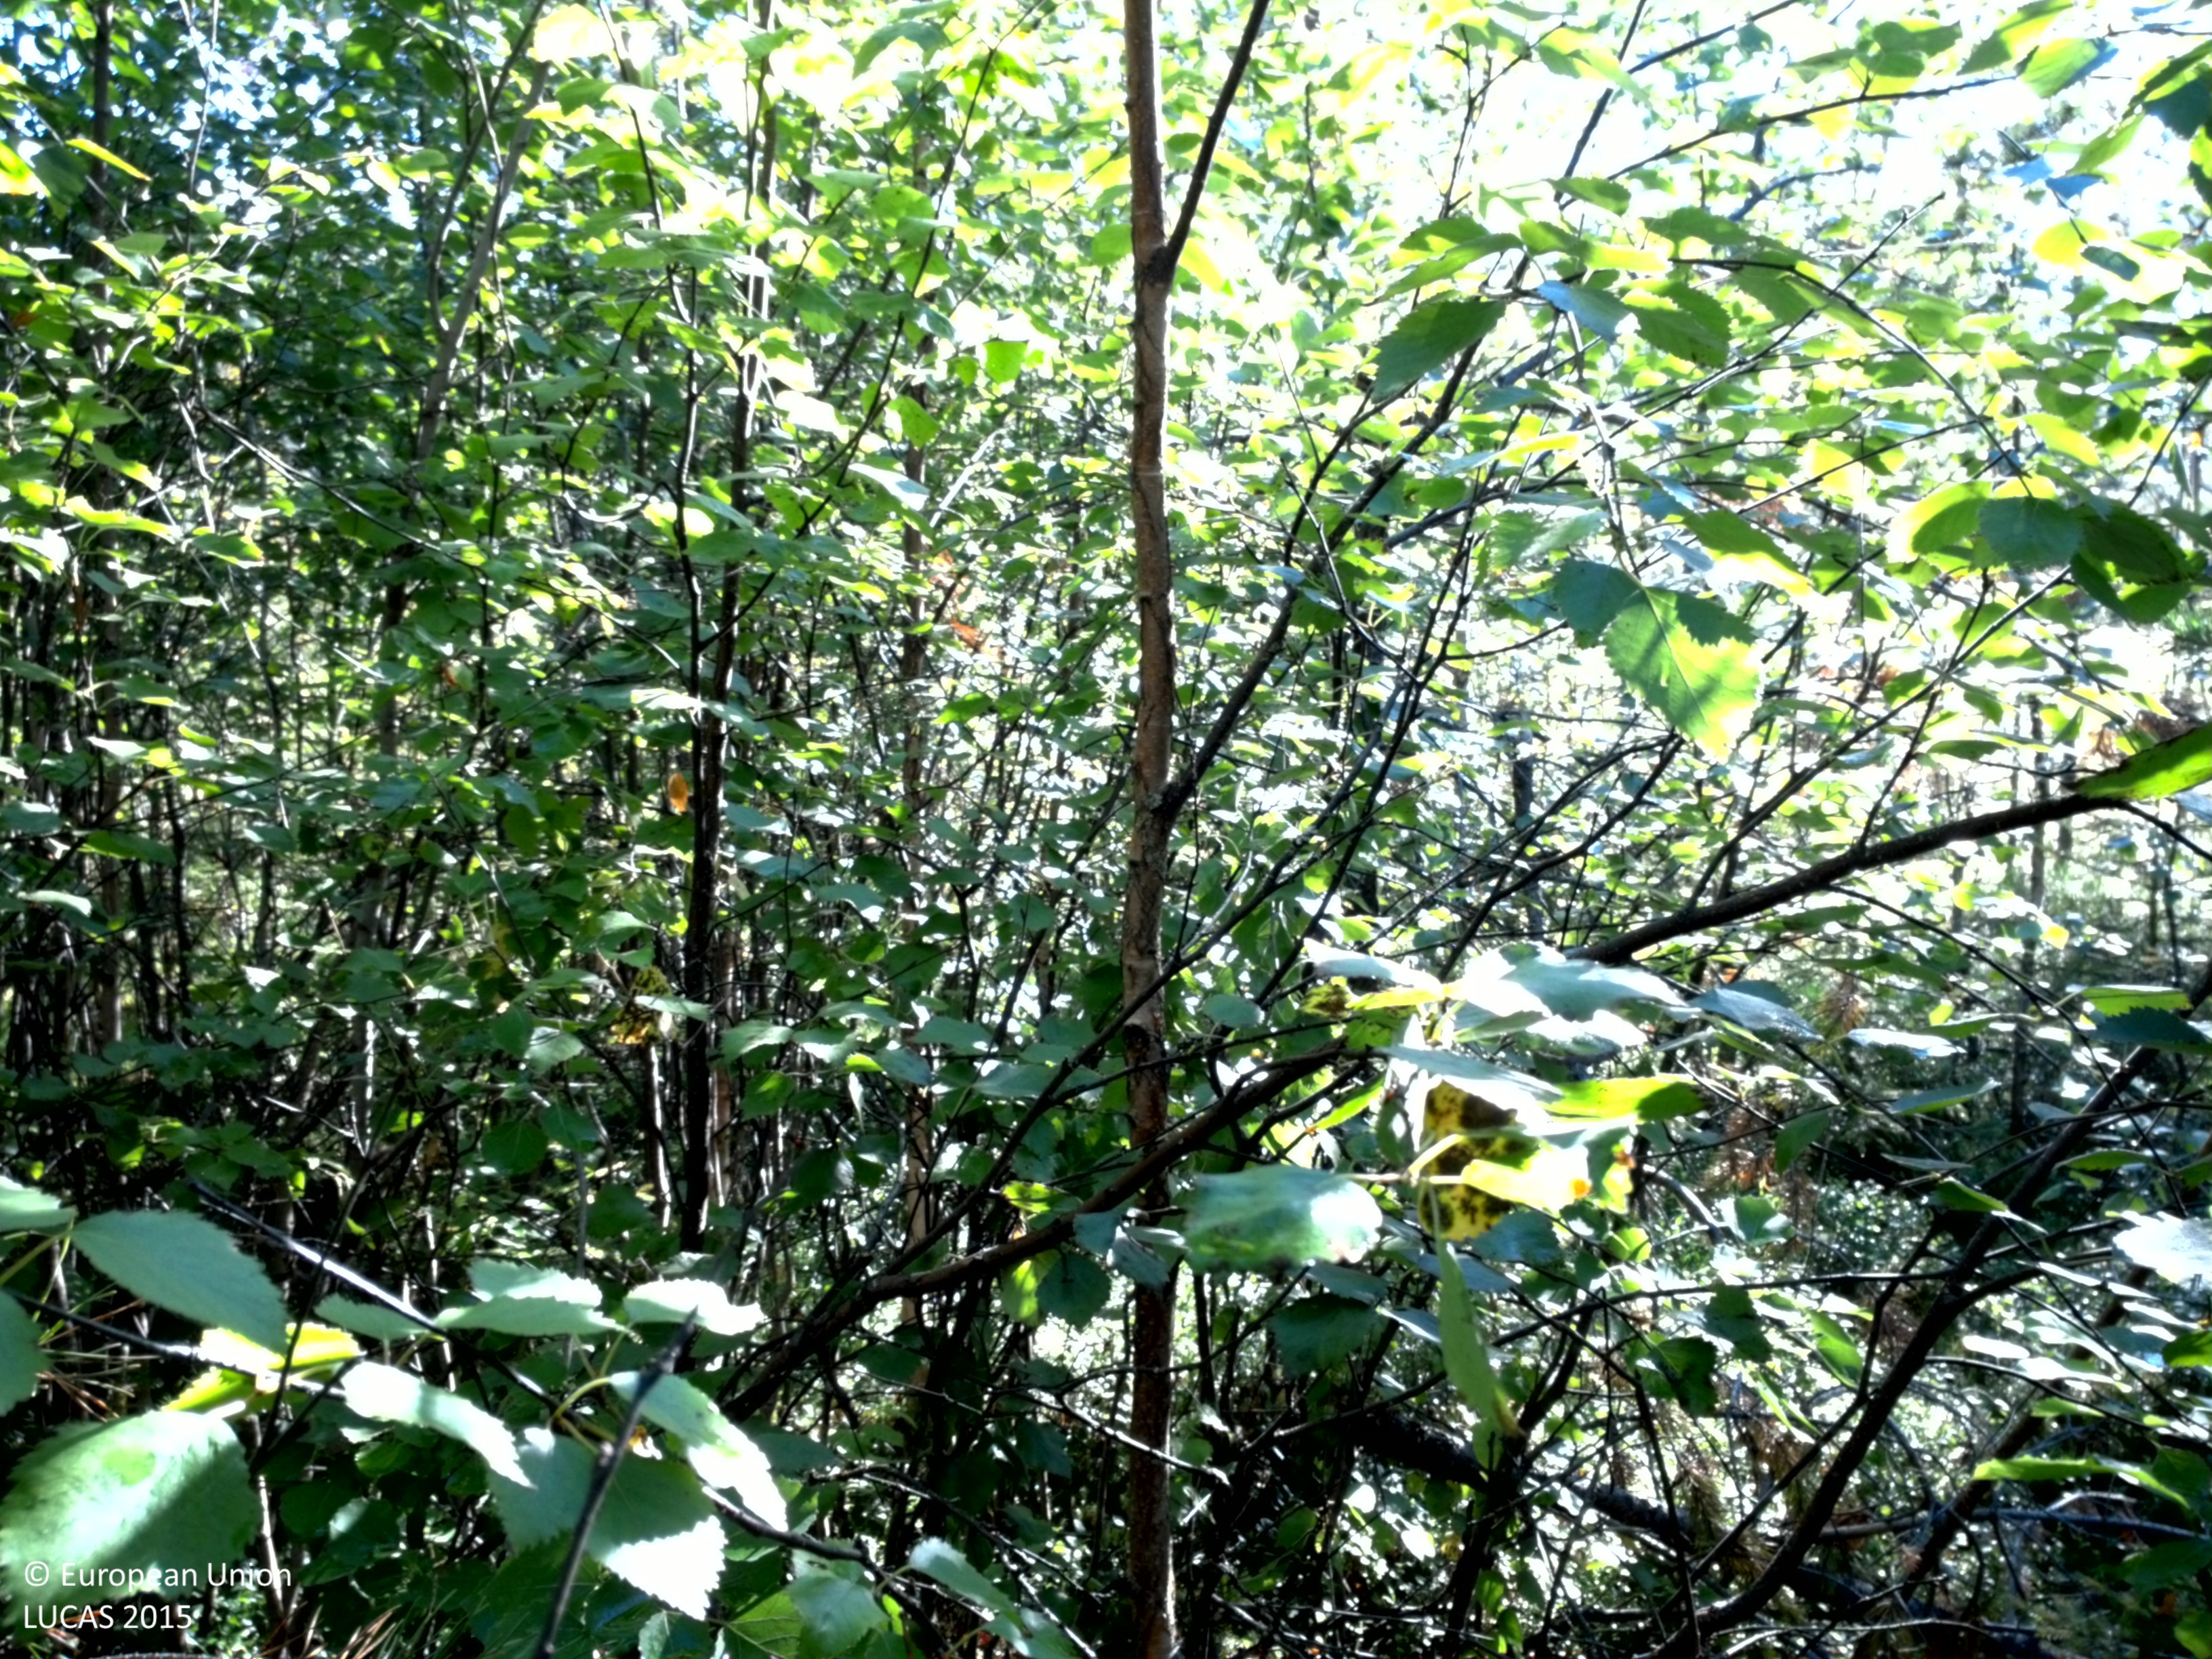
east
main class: Woodland
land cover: Pine dominated mixed woodland
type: boreal forest
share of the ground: 50 - 75 %
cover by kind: broadleaved forest trees 35 %, coniferous forest trees 30 %, shrubs 30 %, lichens and mosses 5 %
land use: Forestry
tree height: > 5 m
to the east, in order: Pine dominated mixed woodland; Pine dominated coniferous woodland; Other mixed woodland; Pine dominated coniferous woodland; Pine dominated mixed woodland
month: August
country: SE
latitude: 66.0636
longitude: 22.5462
